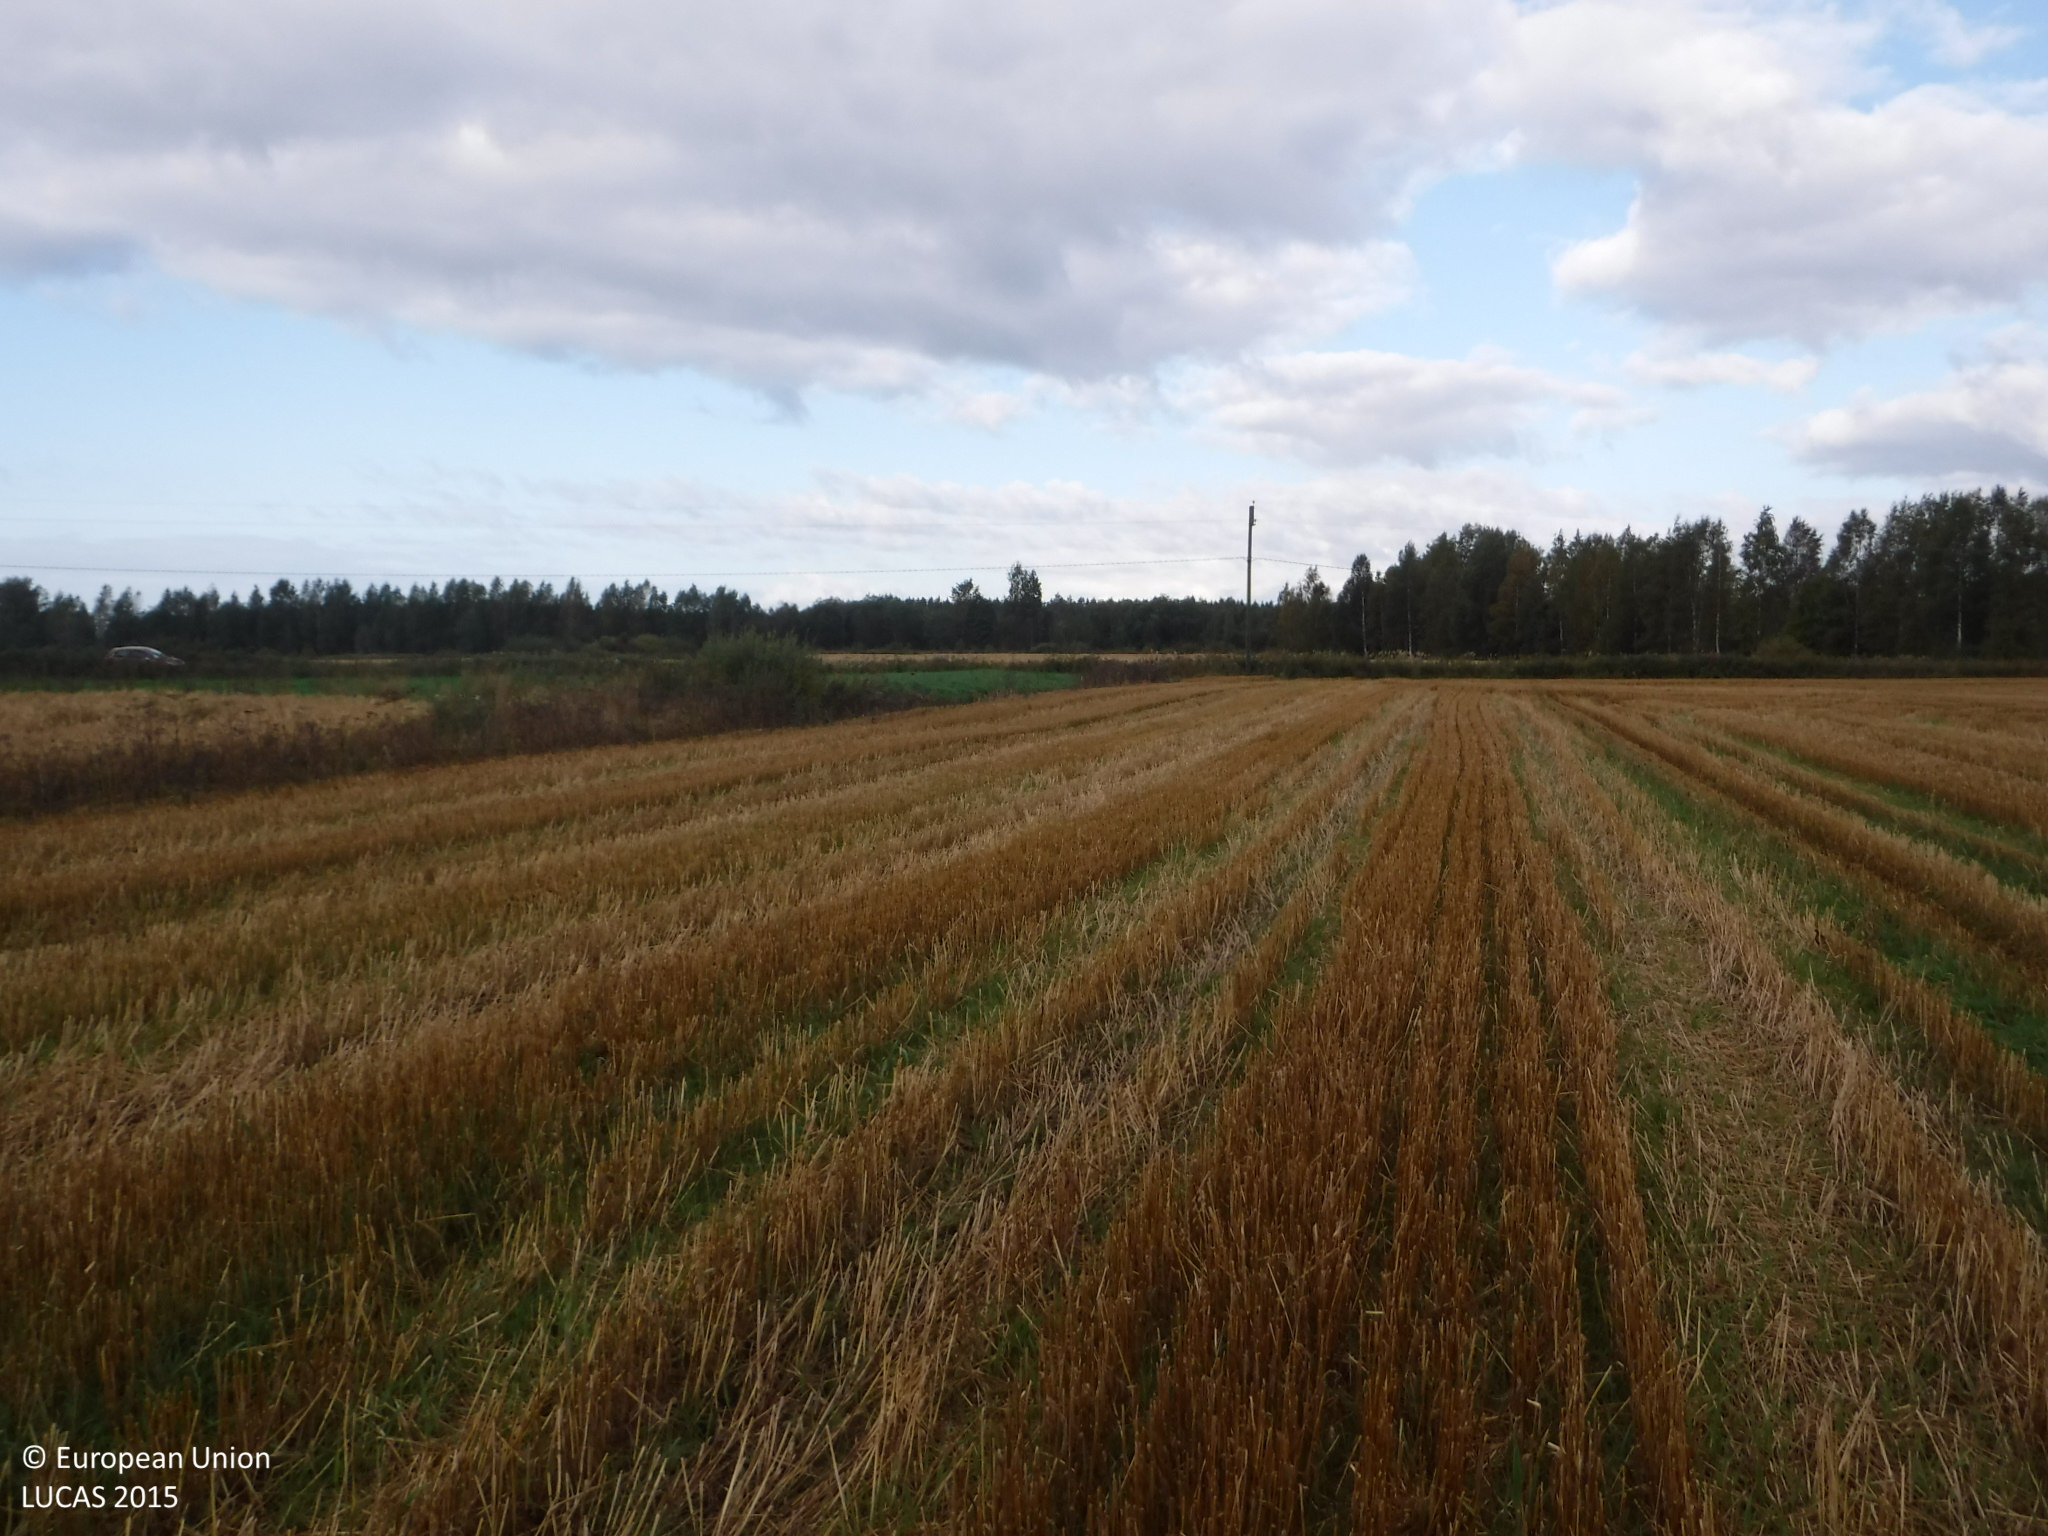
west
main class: Cropland
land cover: Barley
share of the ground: 25 - 50 %
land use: Agriculture (excluding fallow land and kitchen gardens)
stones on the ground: < 10 %
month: September
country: FI
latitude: 61.7458
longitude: 22.2339
